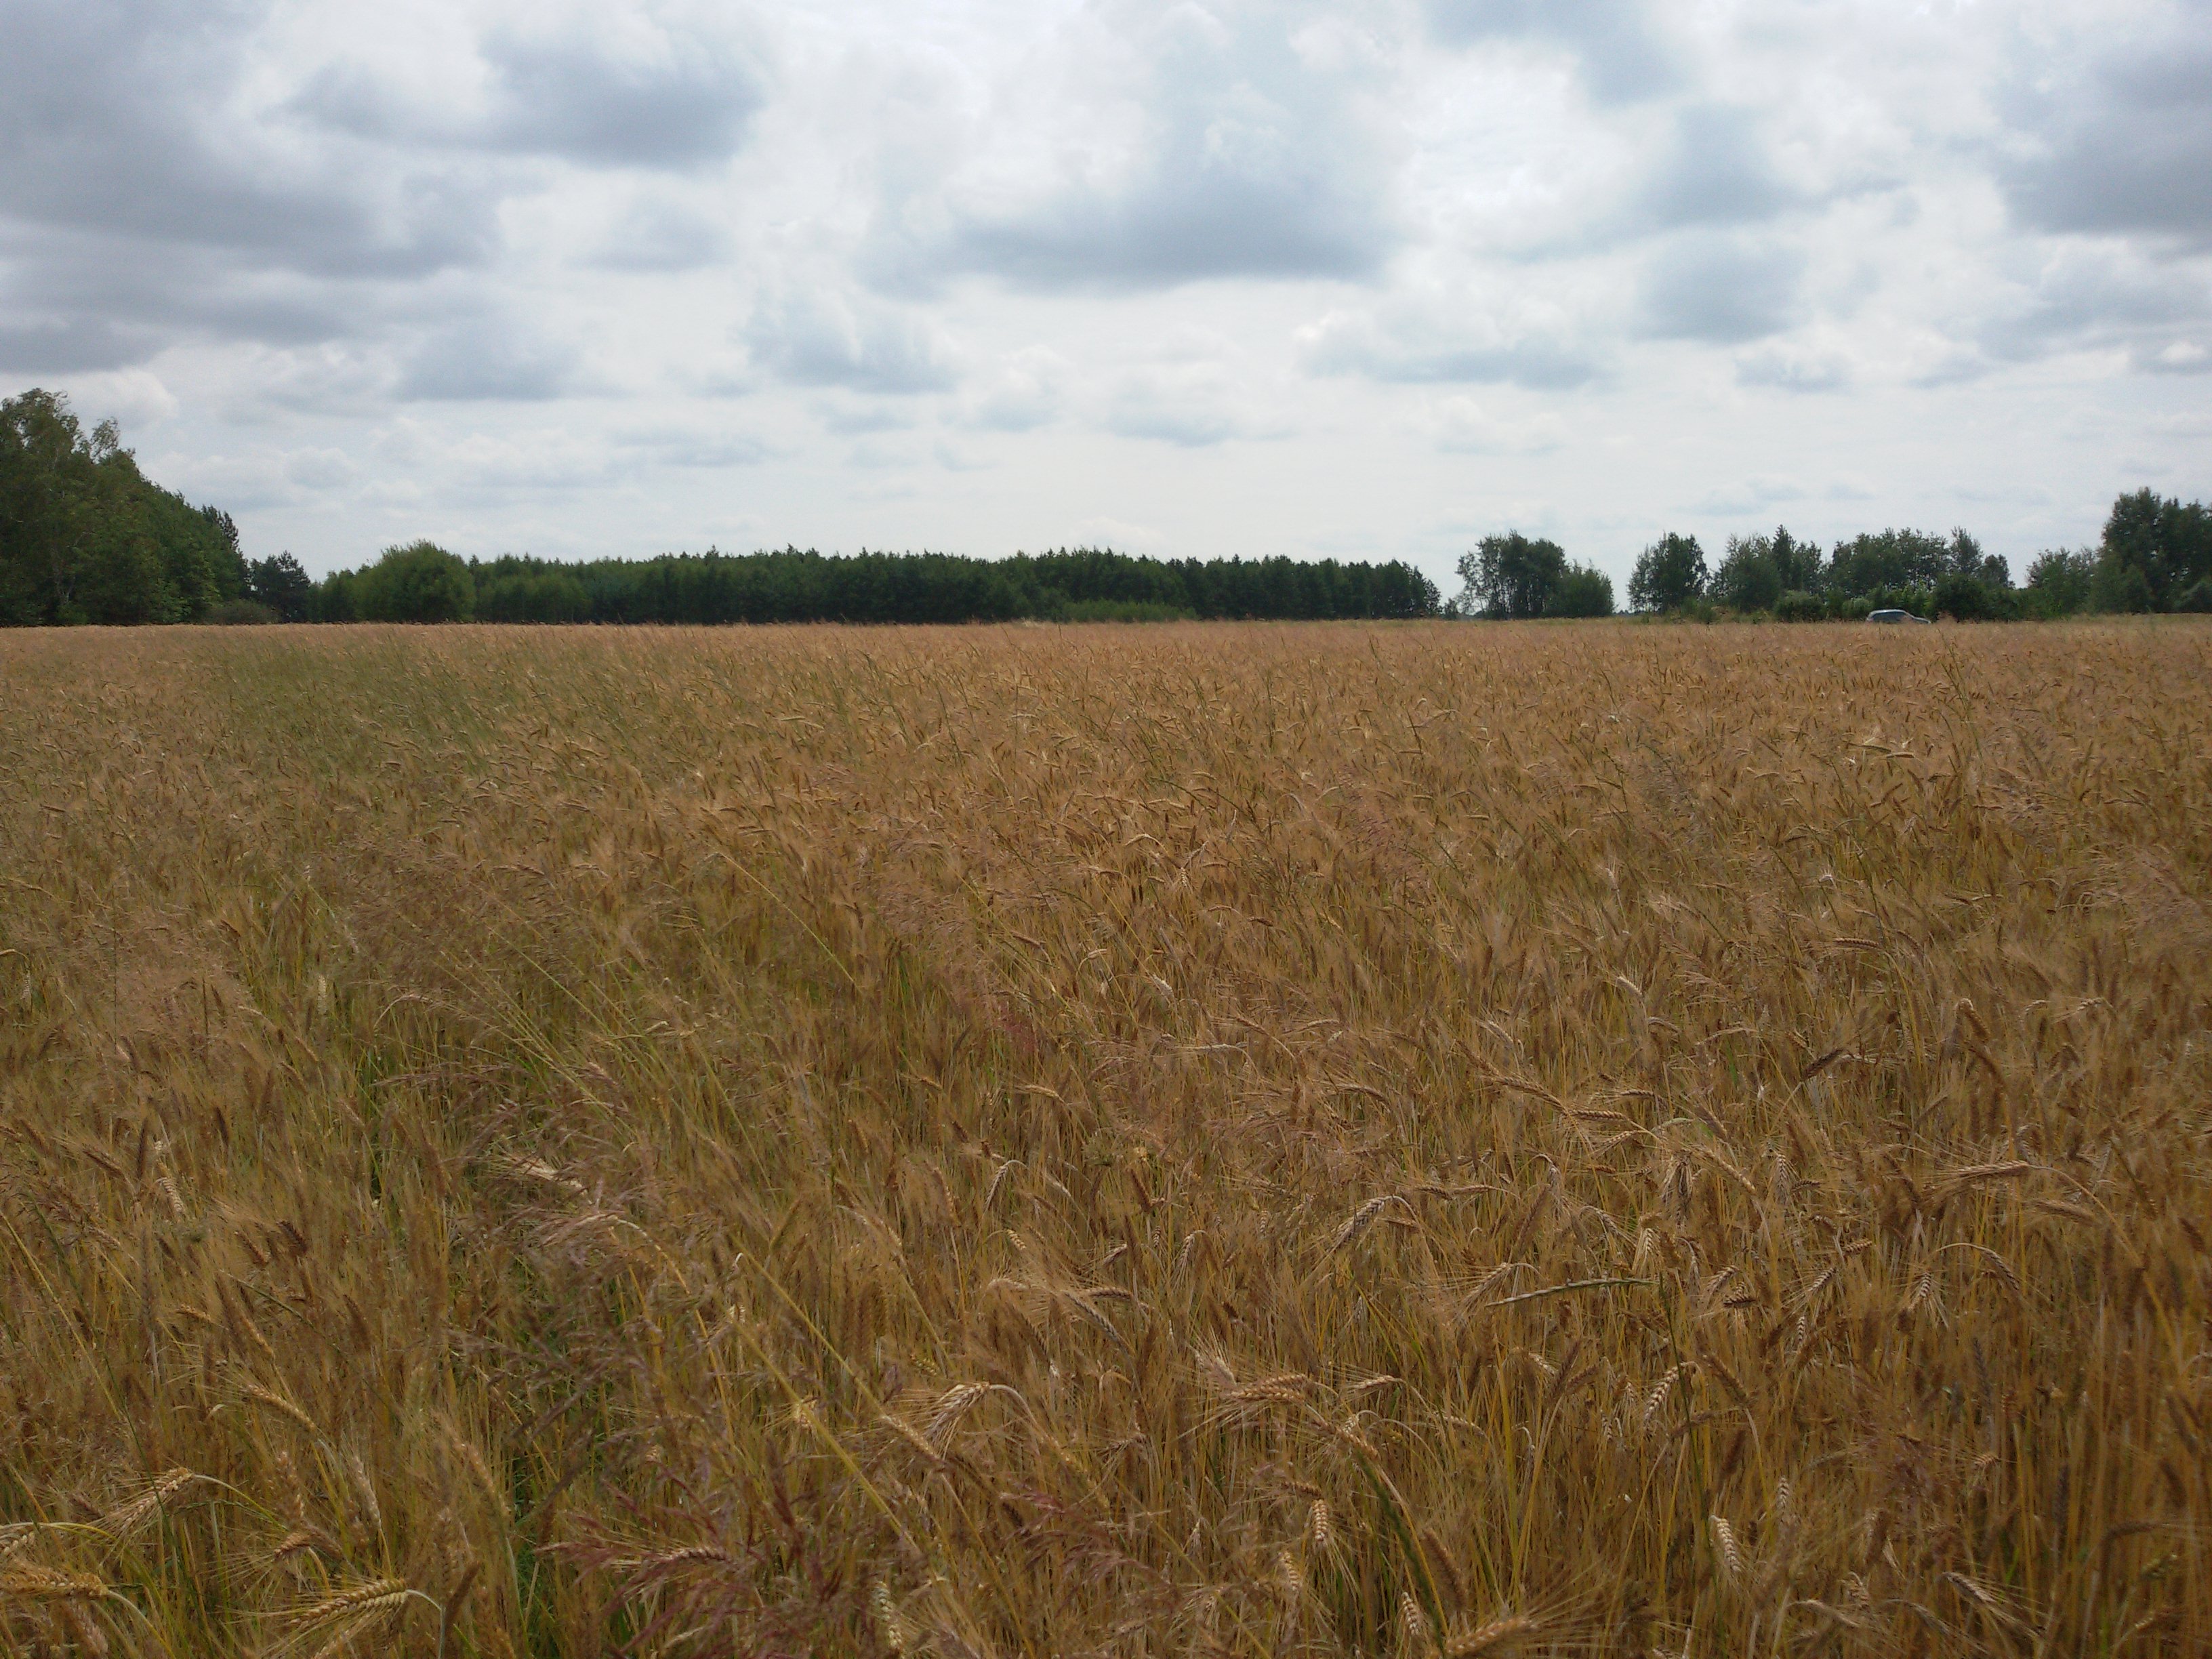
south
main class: Cropland
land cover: Triticale
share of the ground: > 75 %
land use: Agriculture (excluding fallow land and kitchen gardens)
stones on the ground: < 10 %
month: July
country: PL
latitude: 51.8881
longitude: 22.9030
